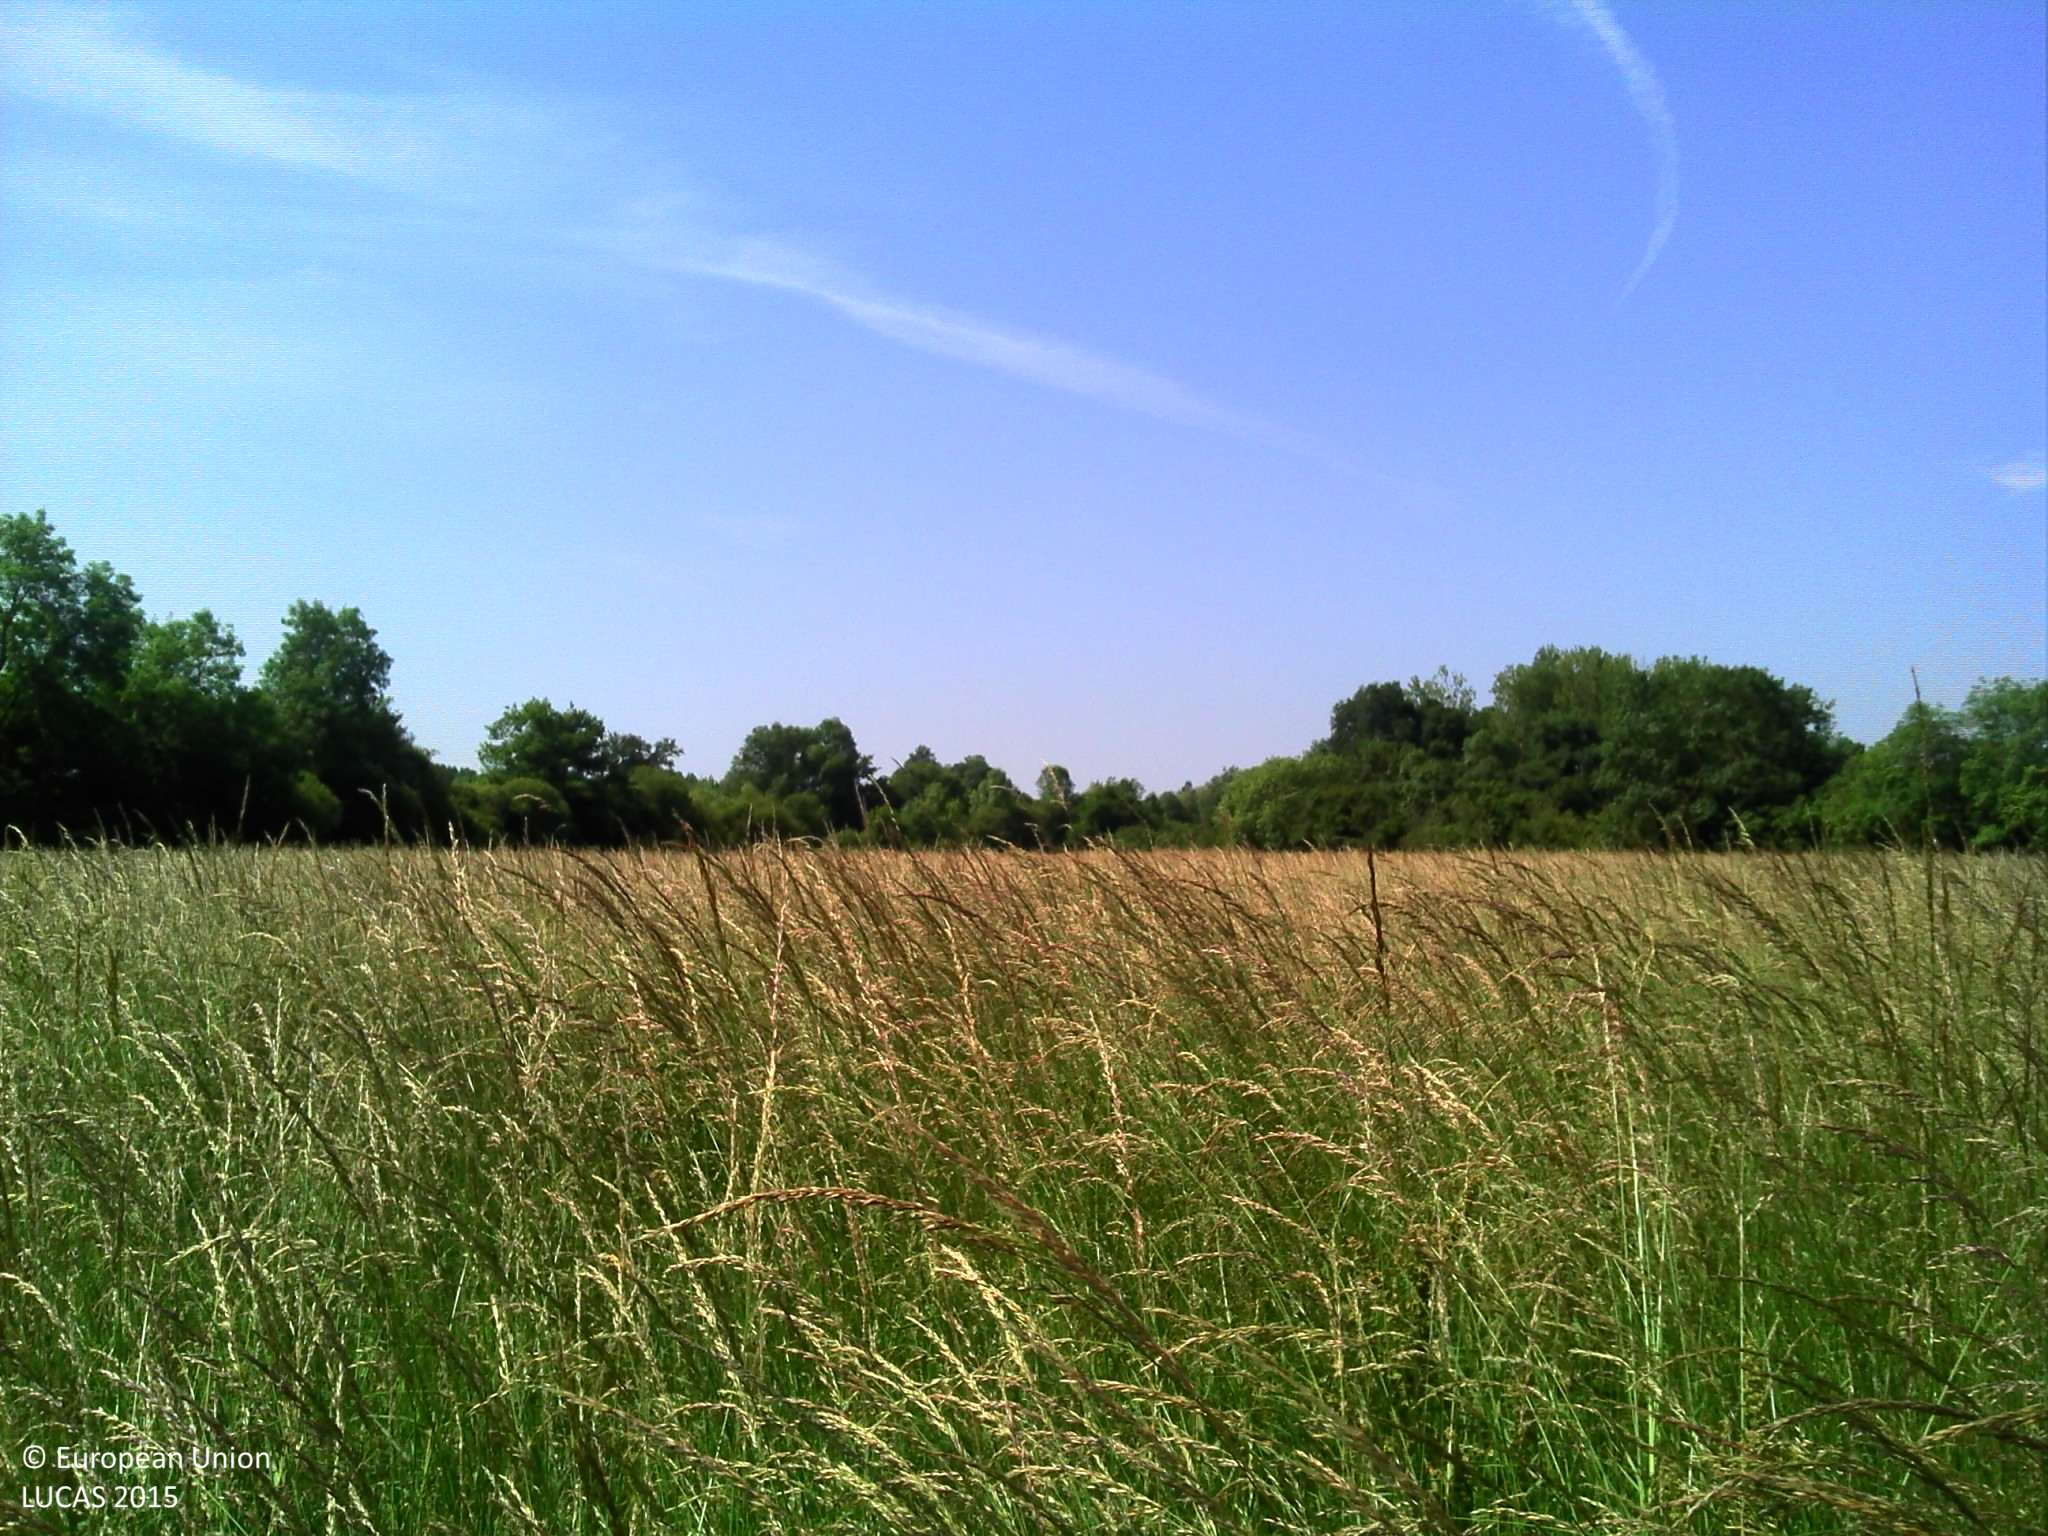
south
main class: Grassland
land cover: Grassland without tree/shrub cover
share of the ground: > 75 %
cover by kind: herbaceous plants 100 %
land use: Agriculture (excluding fallow land and kitchen gardens)
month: June
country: FR
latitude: 47.6994
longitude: 0.0461
